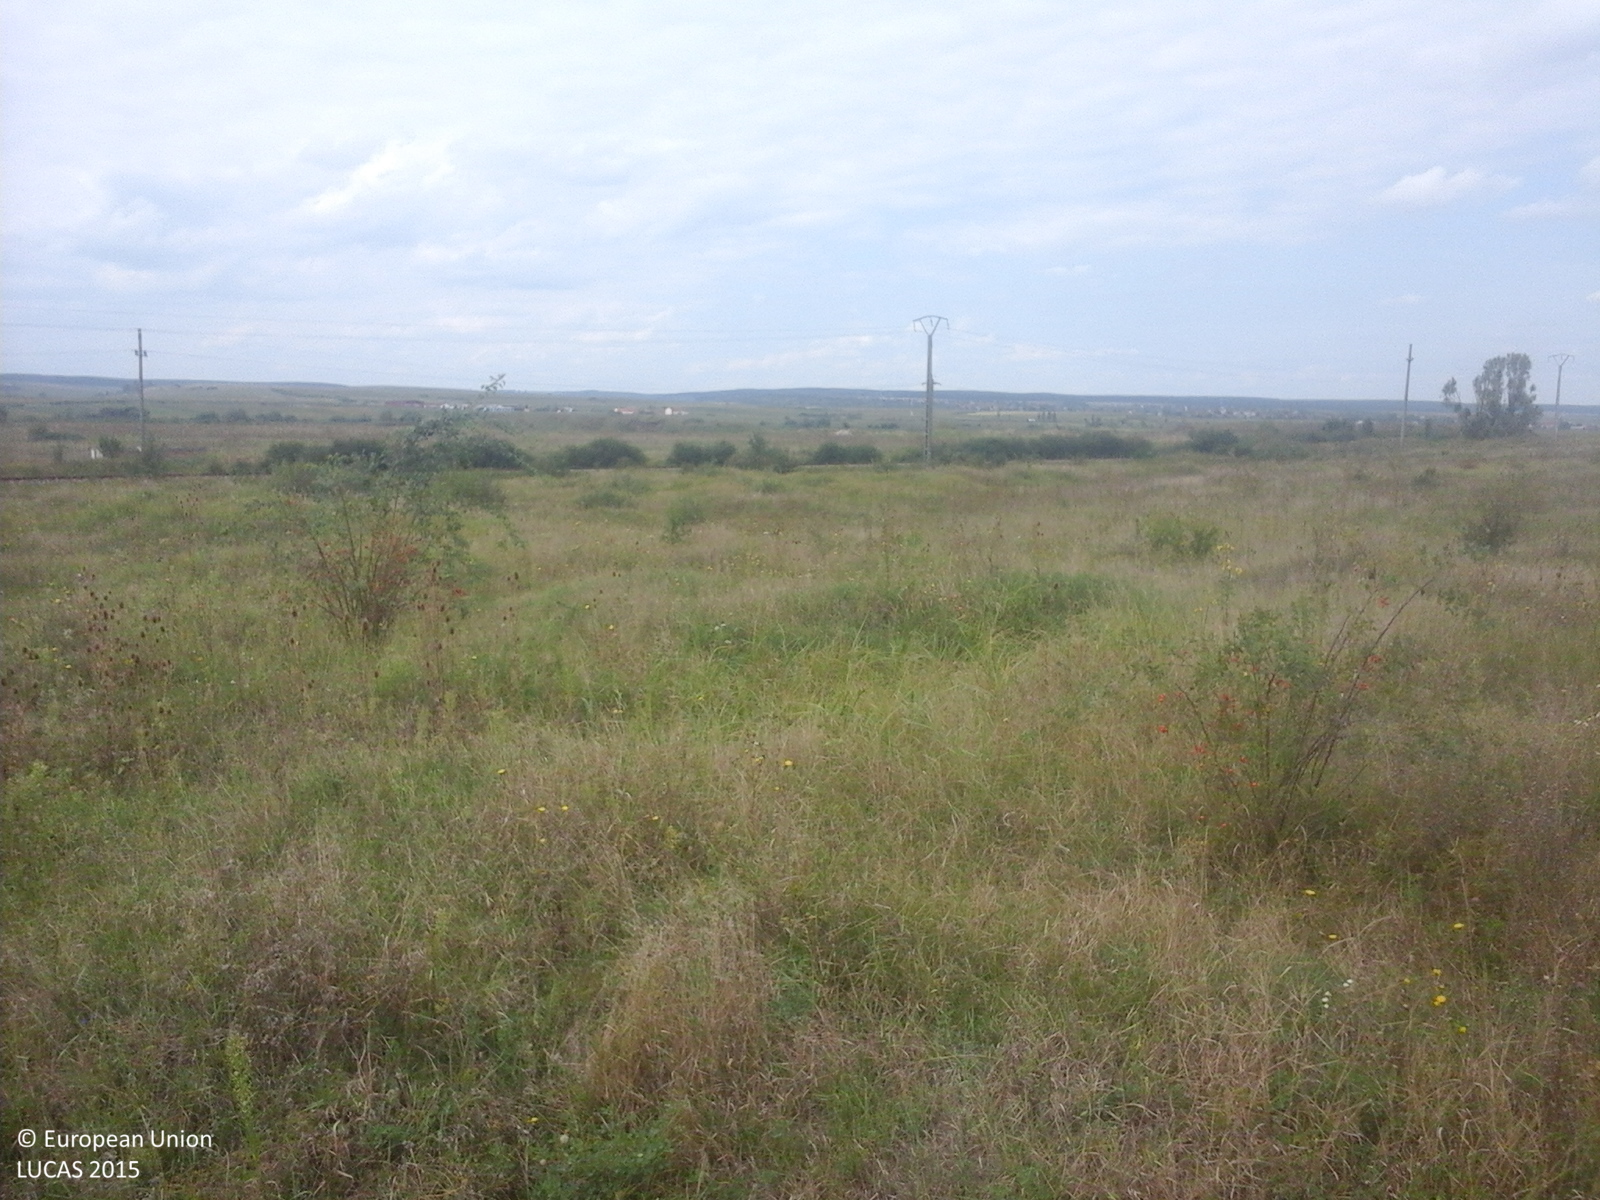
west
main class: Grassland
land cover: Spontaneously vegetated surfaces
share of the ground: > 75 %
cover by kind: herbaceous plants 100 %
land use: Fallow land
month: September
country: RO
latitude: 47.3629
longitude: 22.8122
